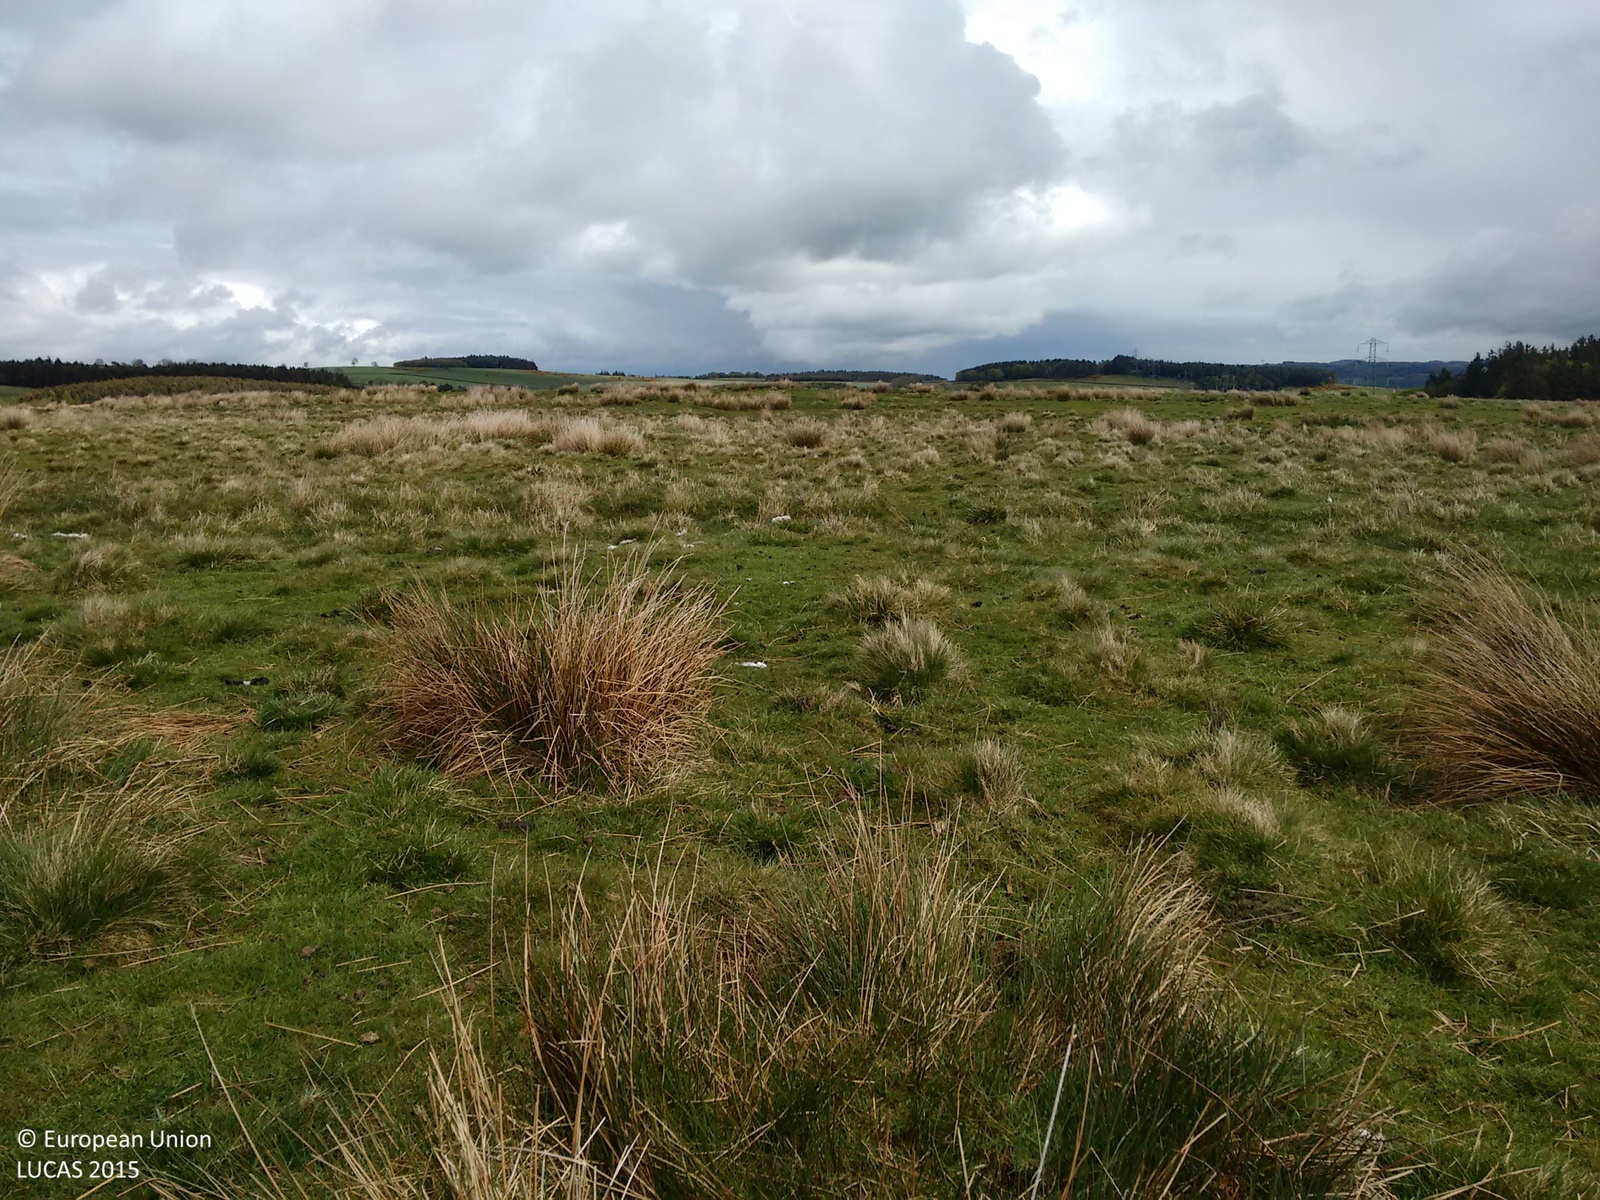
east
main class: Grassland
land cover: Grassland without tree/shrub cover
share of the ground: > 75 %
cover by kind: herbaceous plants 100 %
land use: Agriculture (excluding fallow land and kitchen gardens)
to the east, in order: Grassland without tree/shrub cover
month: May
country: GB
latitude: 55.0194
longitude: -2.2105
